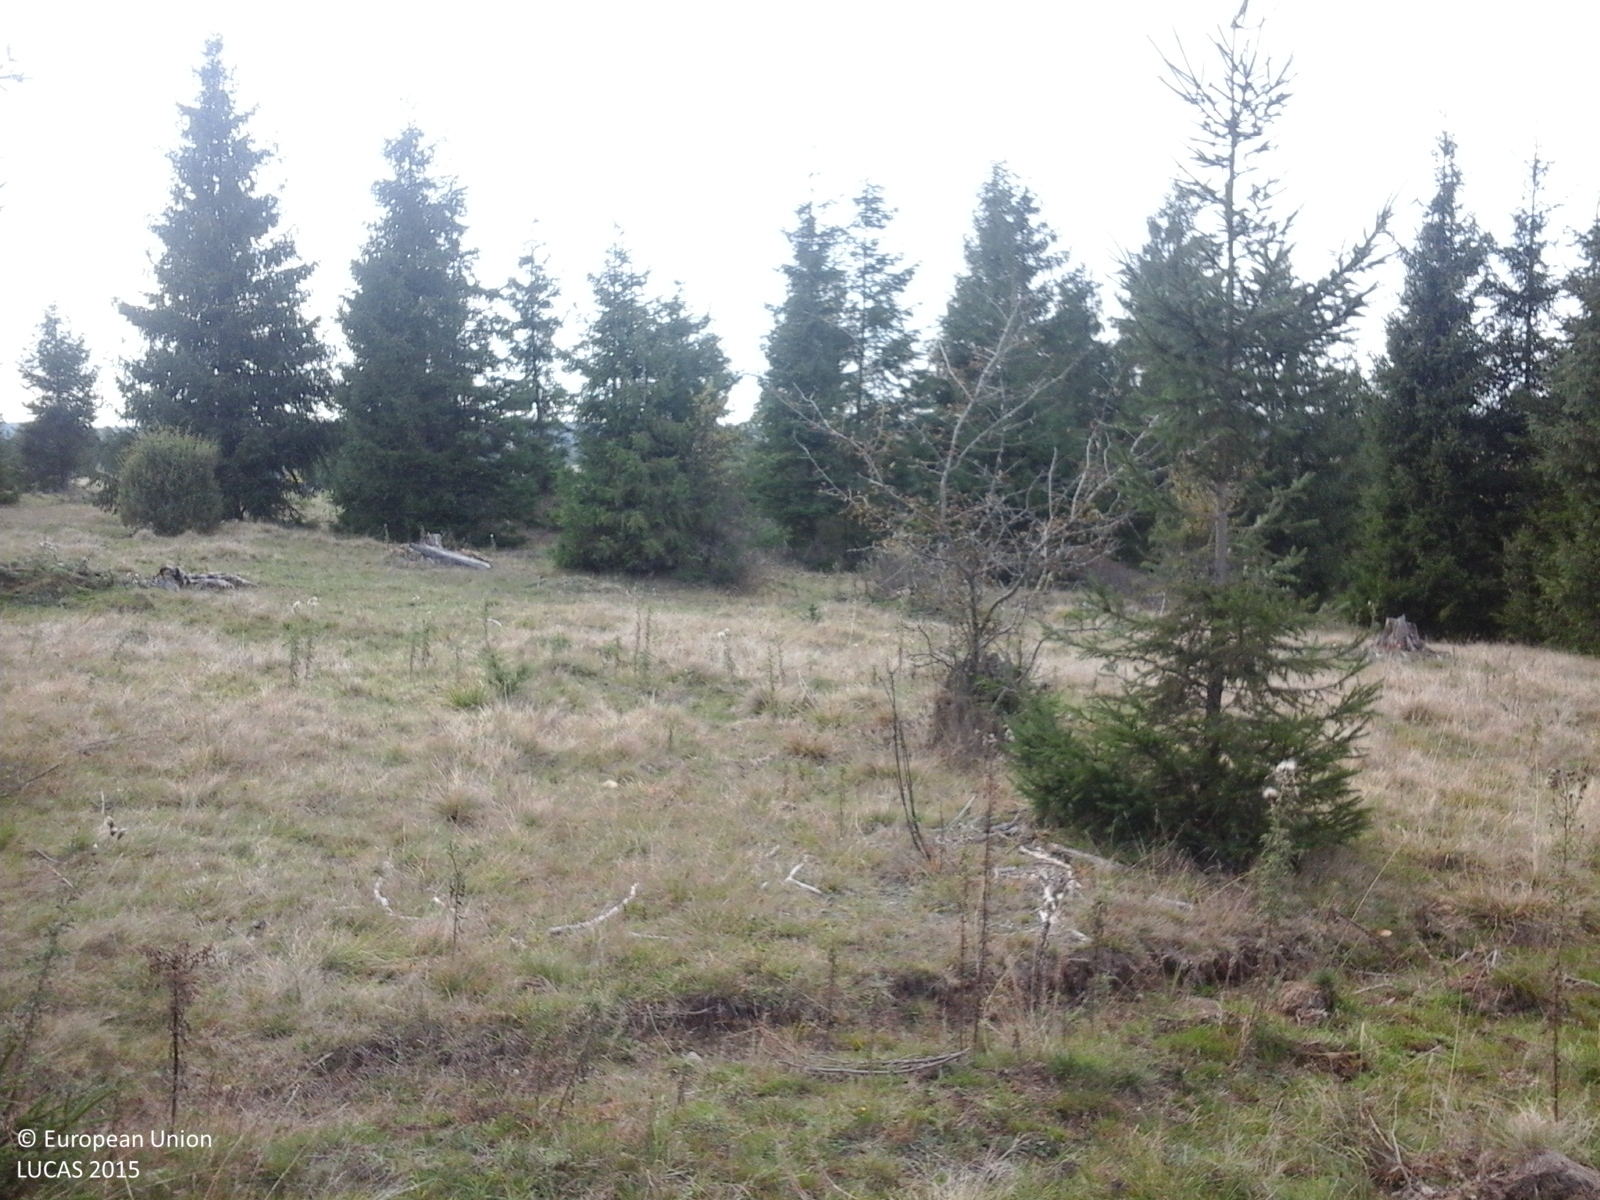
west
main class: Grassland
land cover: Grassland with sparse tree/shrub cover
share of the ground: > 75 %
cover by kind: herbaceous plants 85 %, shrubs 10 %, broadleaved forest trees 5 %
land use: Fallow land
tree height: < 5 m
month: October
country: RO
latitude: 46.3907
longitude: 25.4652
